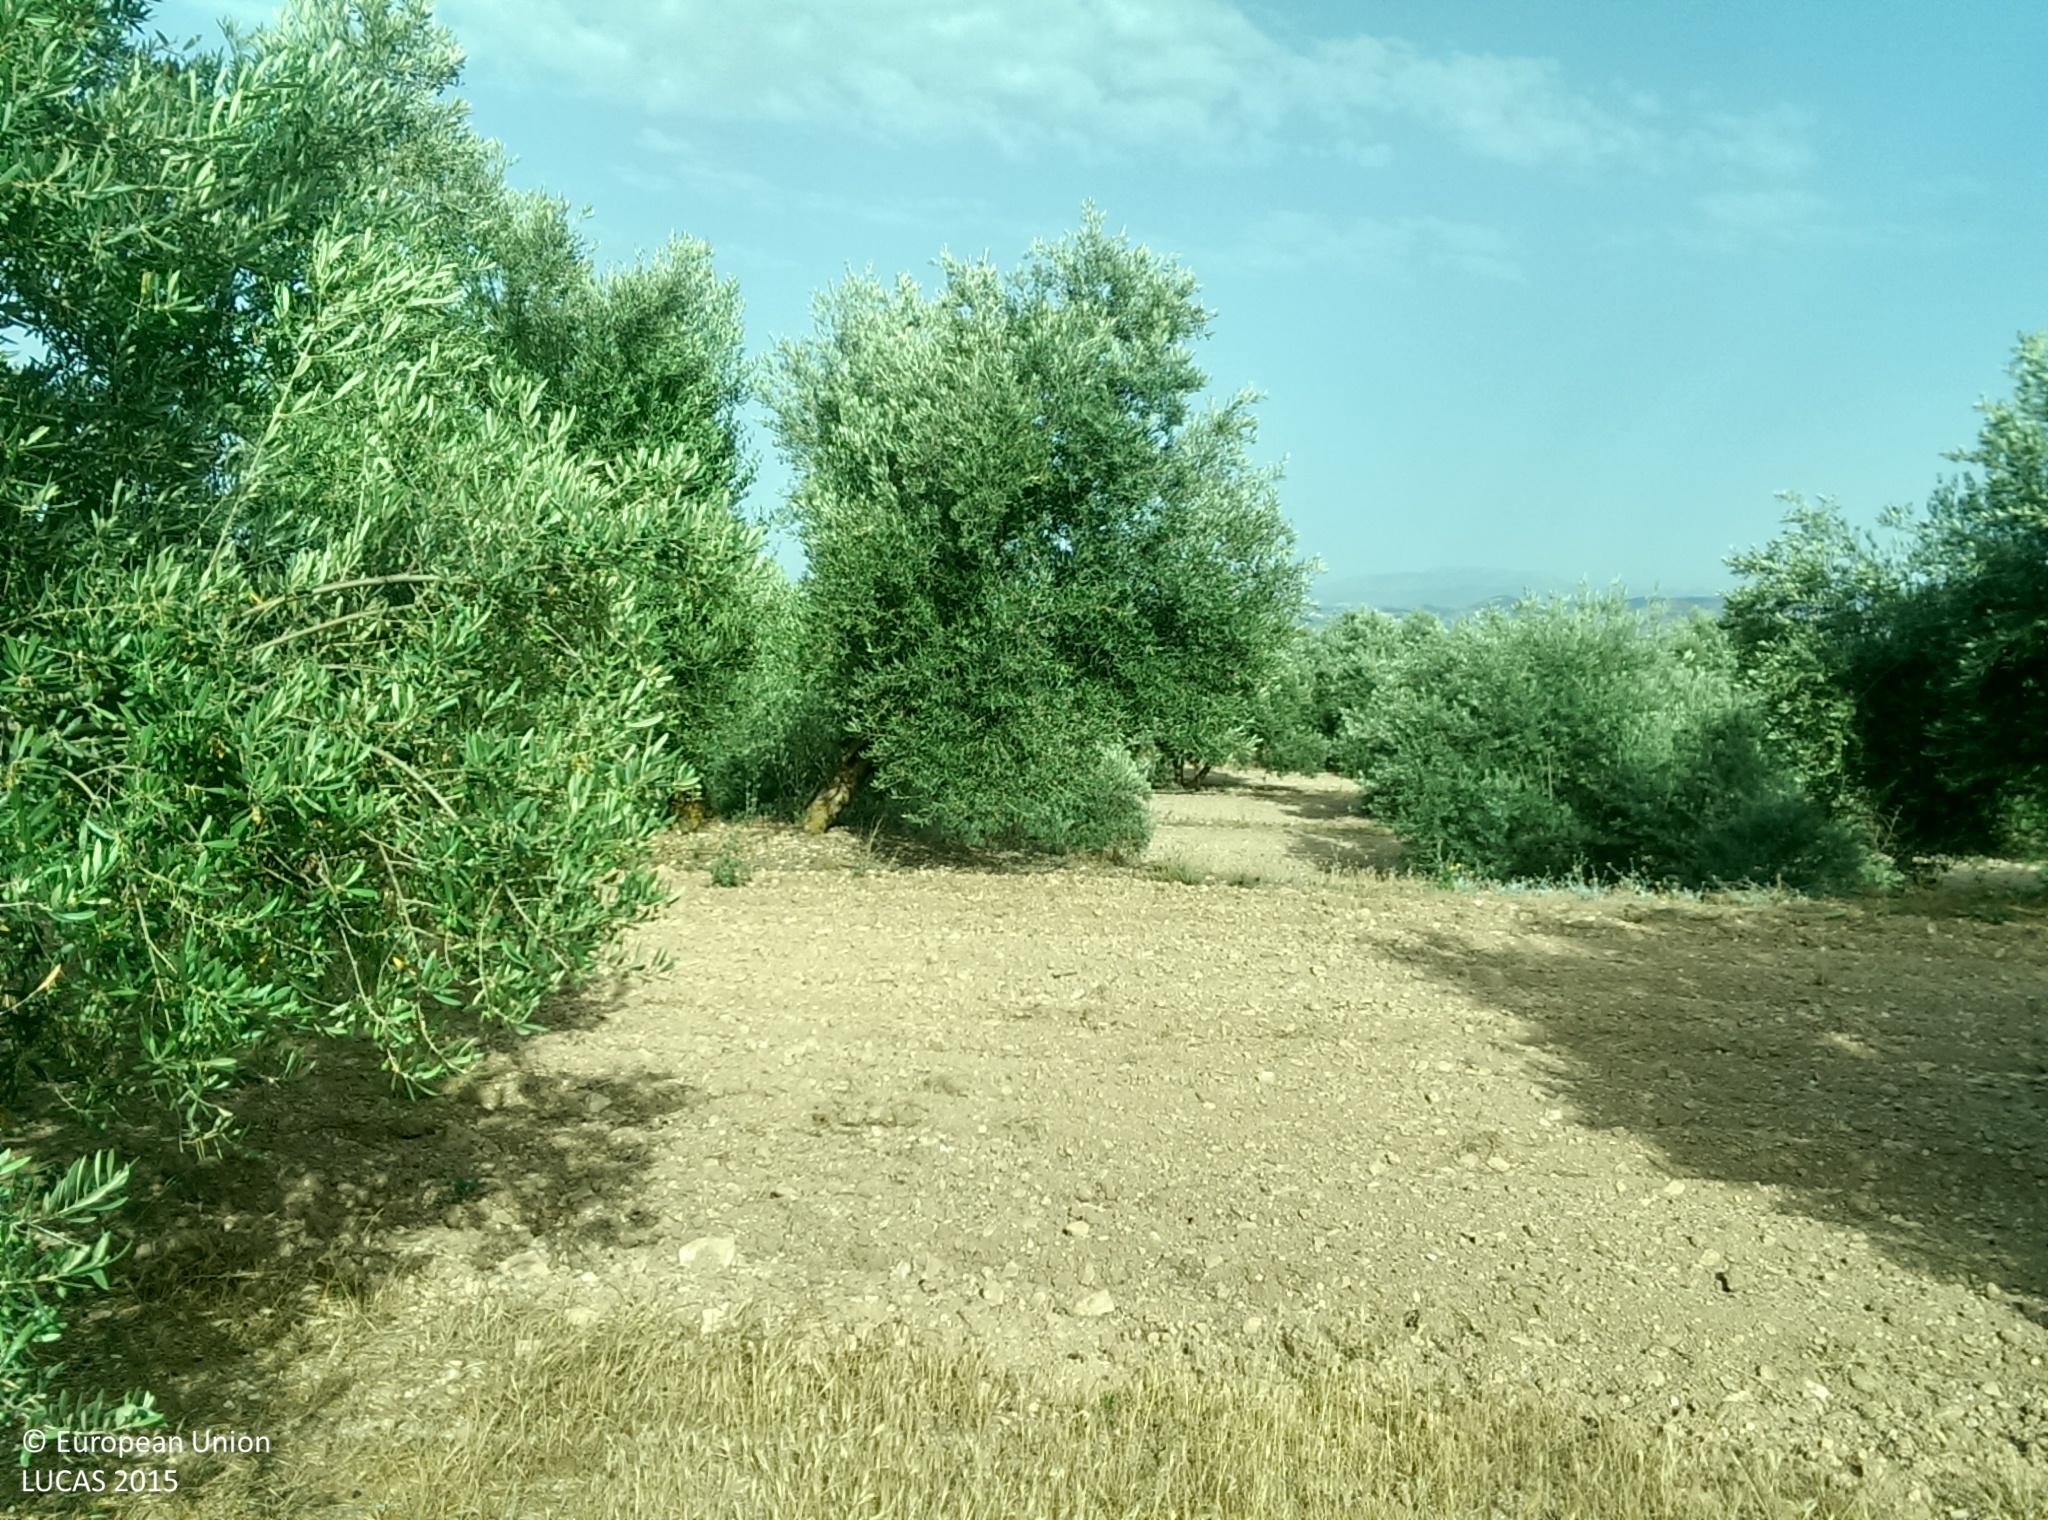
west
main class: Cropland
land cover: Olive groves
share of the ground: 50 - 75 %
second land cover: Other bare soil
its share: > 75 %
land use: Agriculture (excluding fallow land and kitchen gardens)
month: July
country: ES
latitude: 37.6146
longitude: -2.9163
